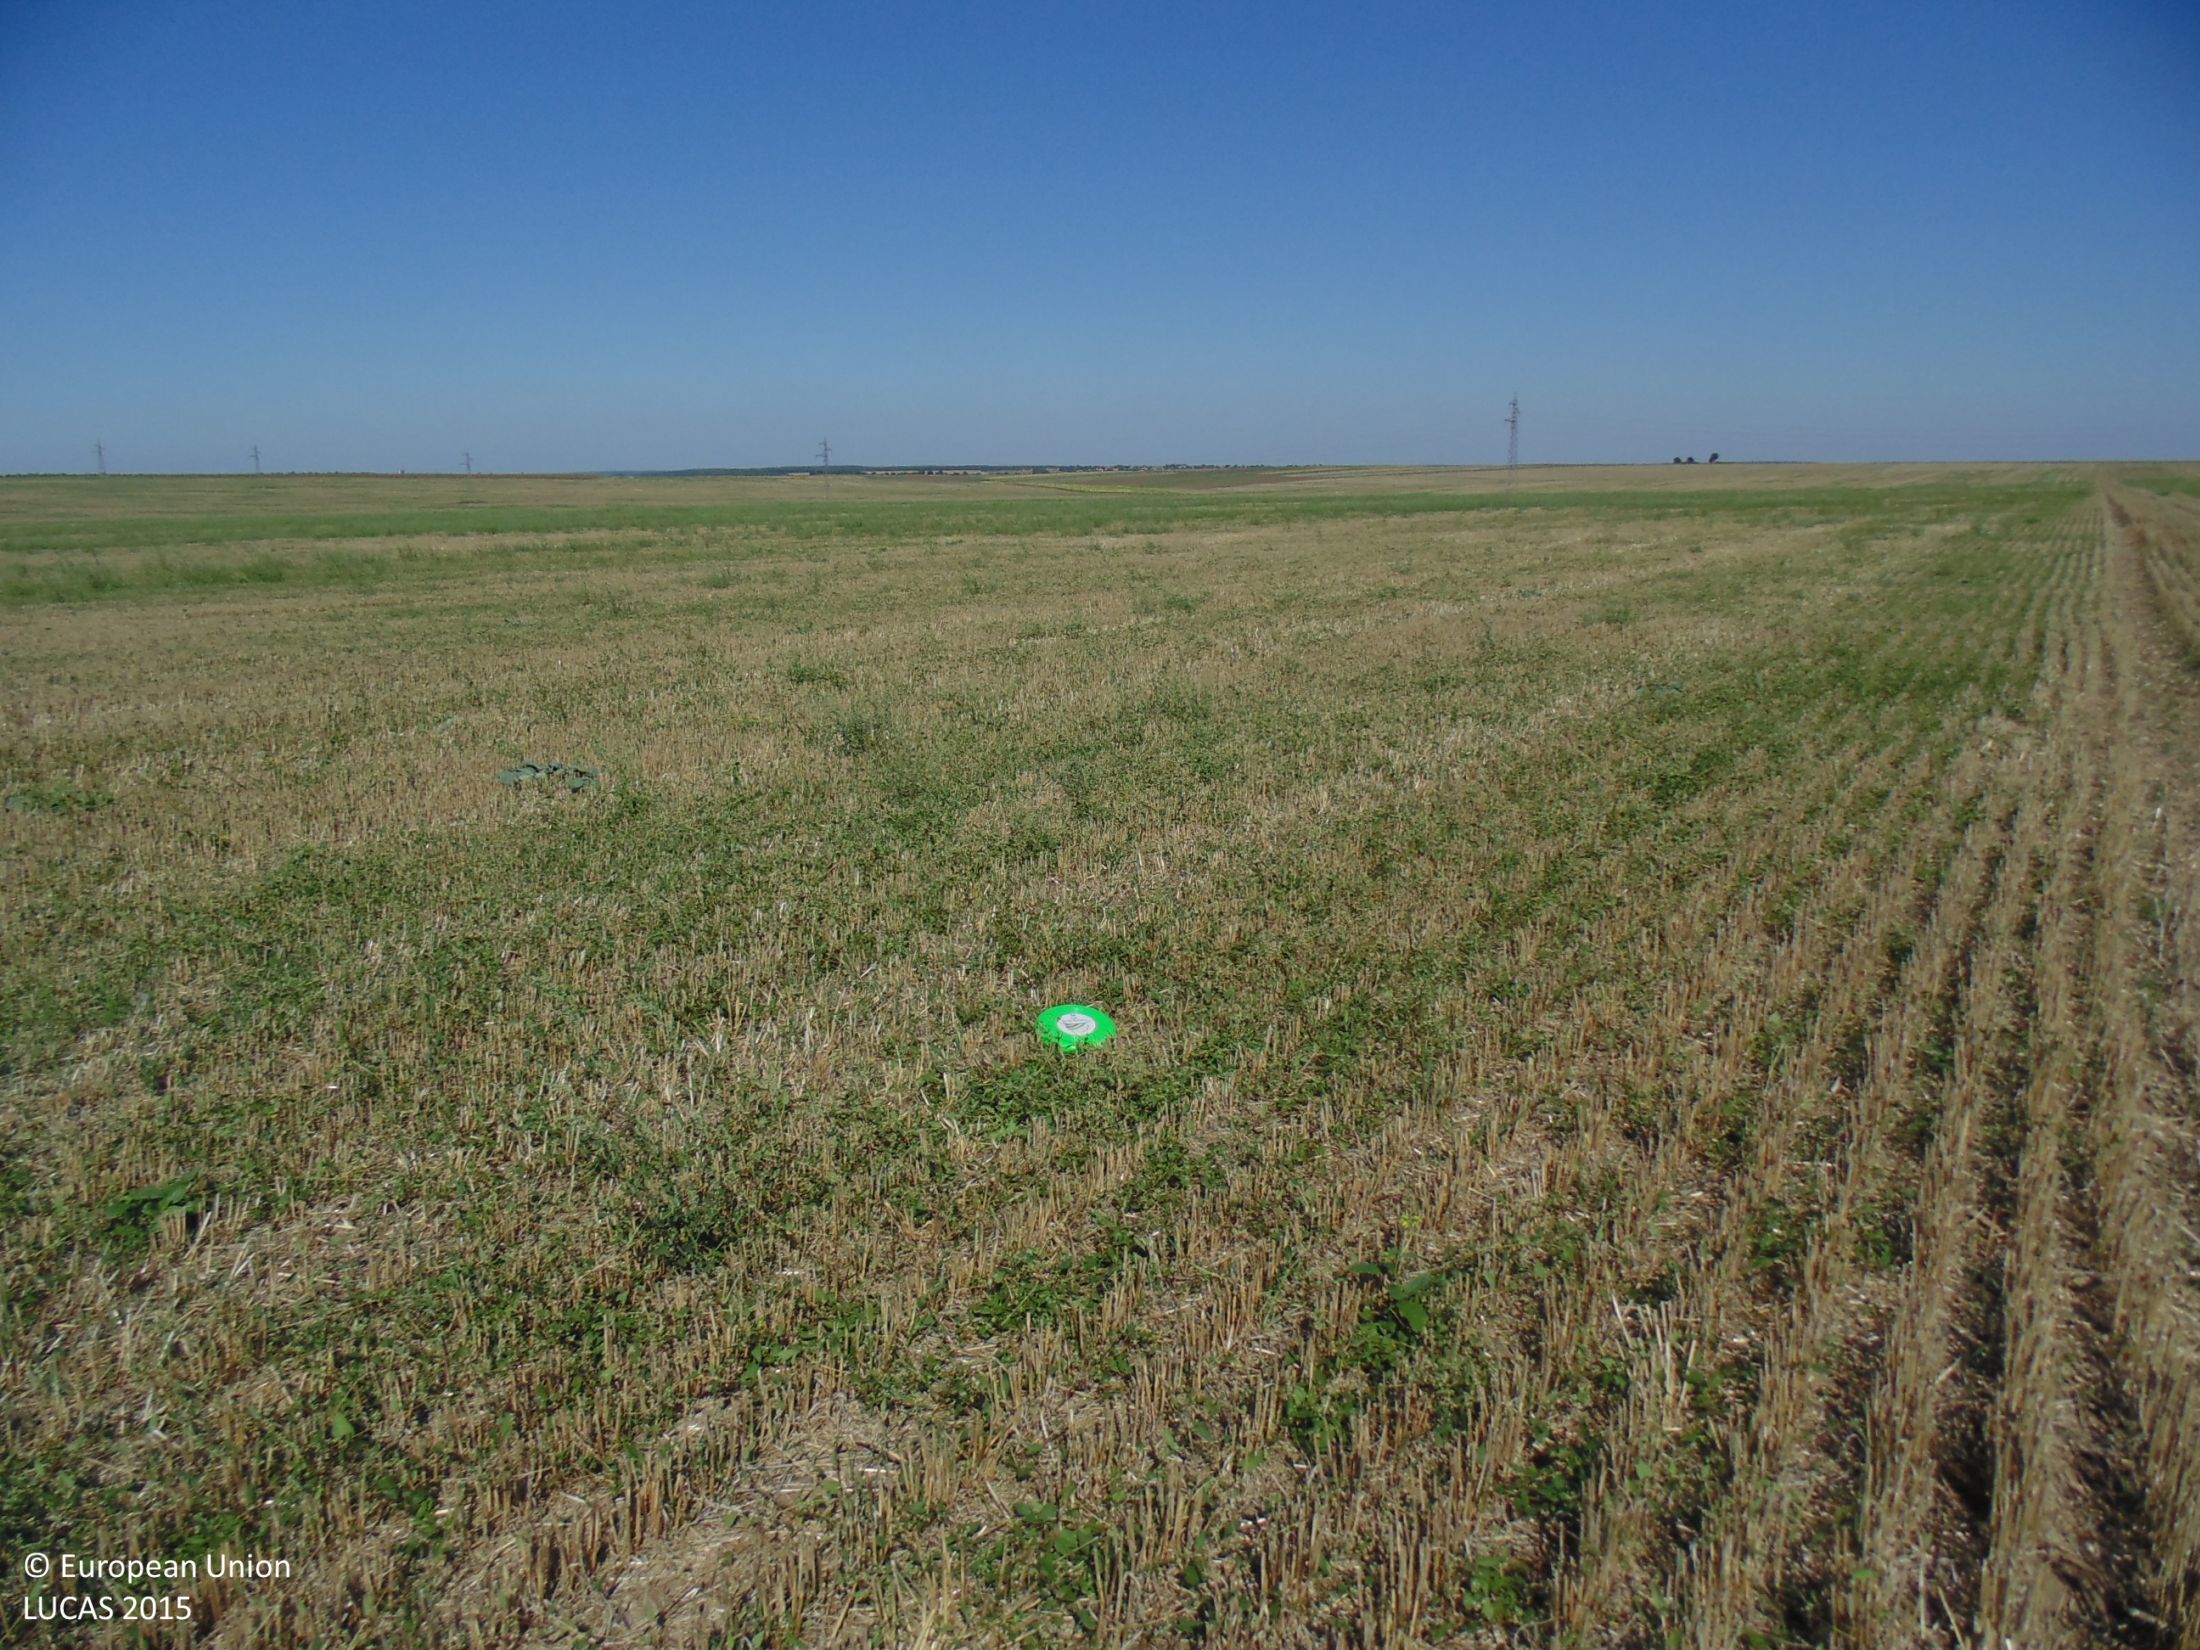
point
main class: Cropland
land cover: Common wheat
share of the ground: 50 - 75 %
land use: Agriculture (excluding fallow land and kitchen gardens)
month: September
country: BG
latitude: 43.7561
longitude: 27.1525
